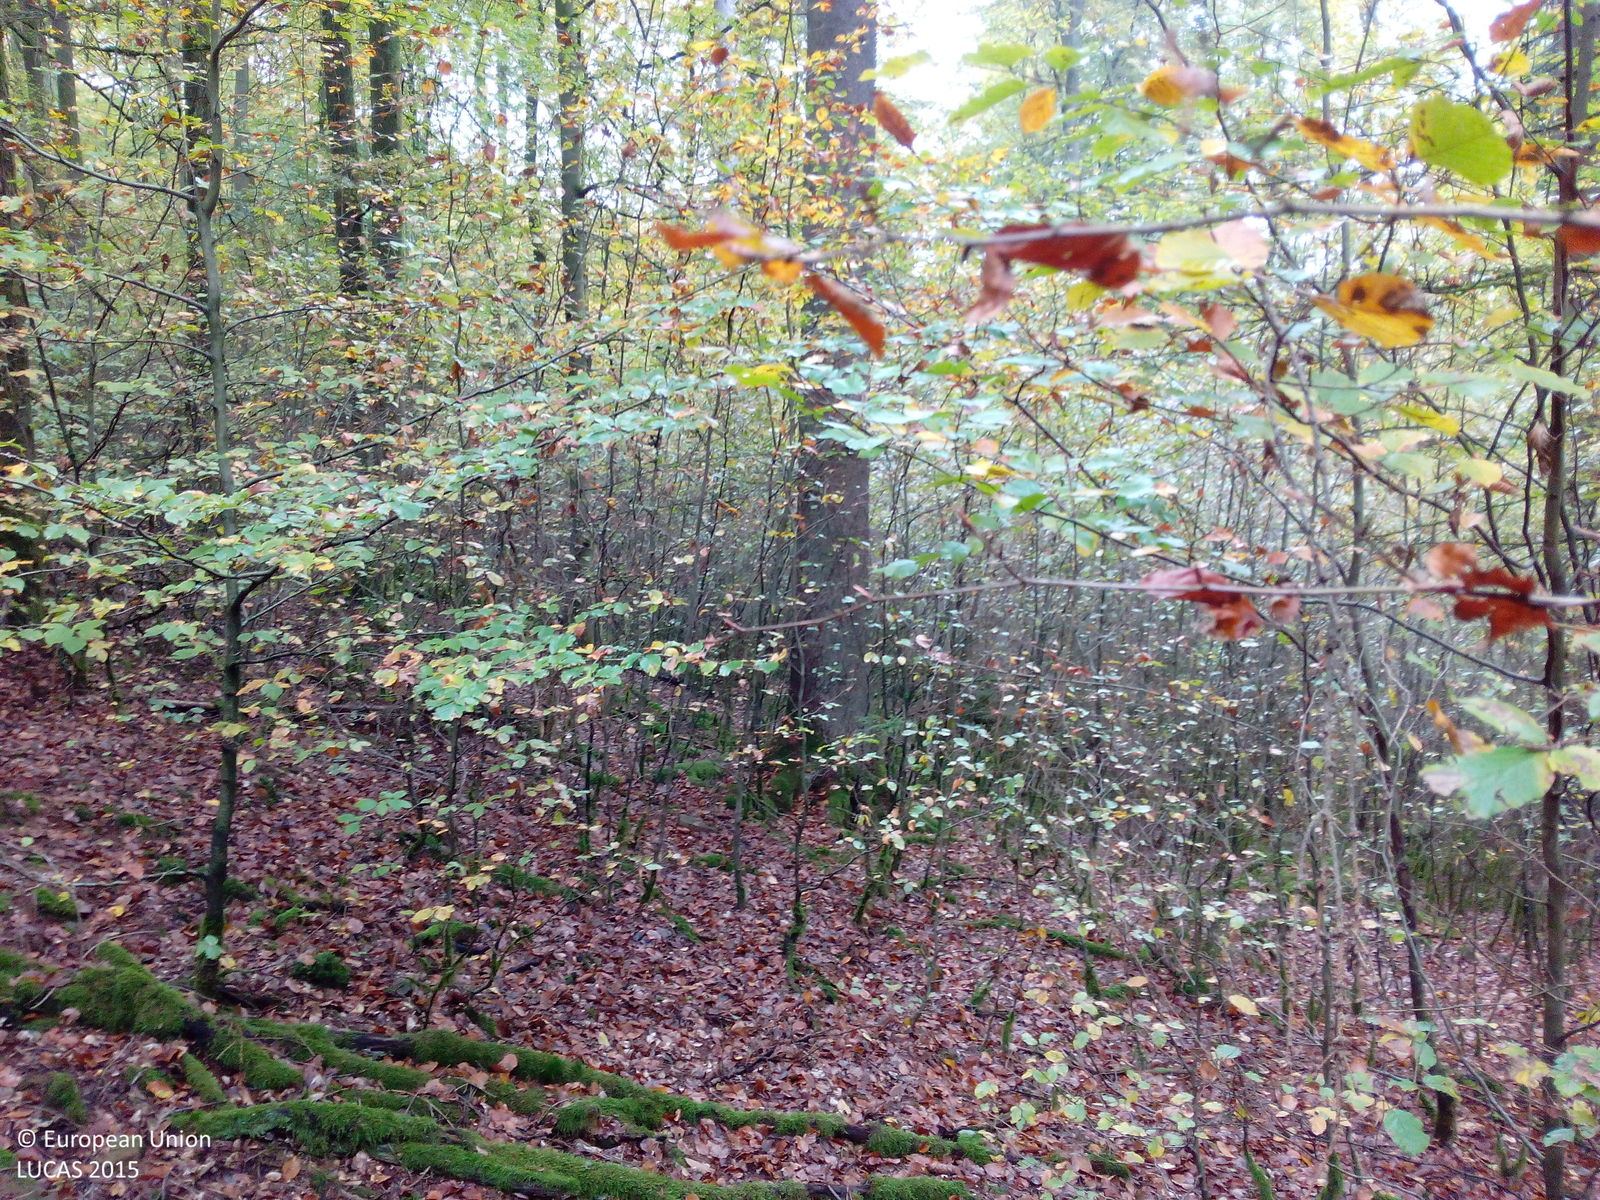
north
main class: Woodland
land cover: Spruce dominated mixed woodland
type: hemiboreal forest and nemoral coniferous forest and mixed broadleaved-coniferous forest
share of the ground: 50 - 75 %
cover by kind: broadleaved forest trees 40 %, coniferous forest trees 25 %, lichens and mosses 15 %, unconsolidated bare surface 10 %, shrubs 5 %, herbaceous plants 5 %
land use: Forestry
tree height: > 5 m
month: October
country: DE
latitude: 50.2554
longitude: 9.5934
